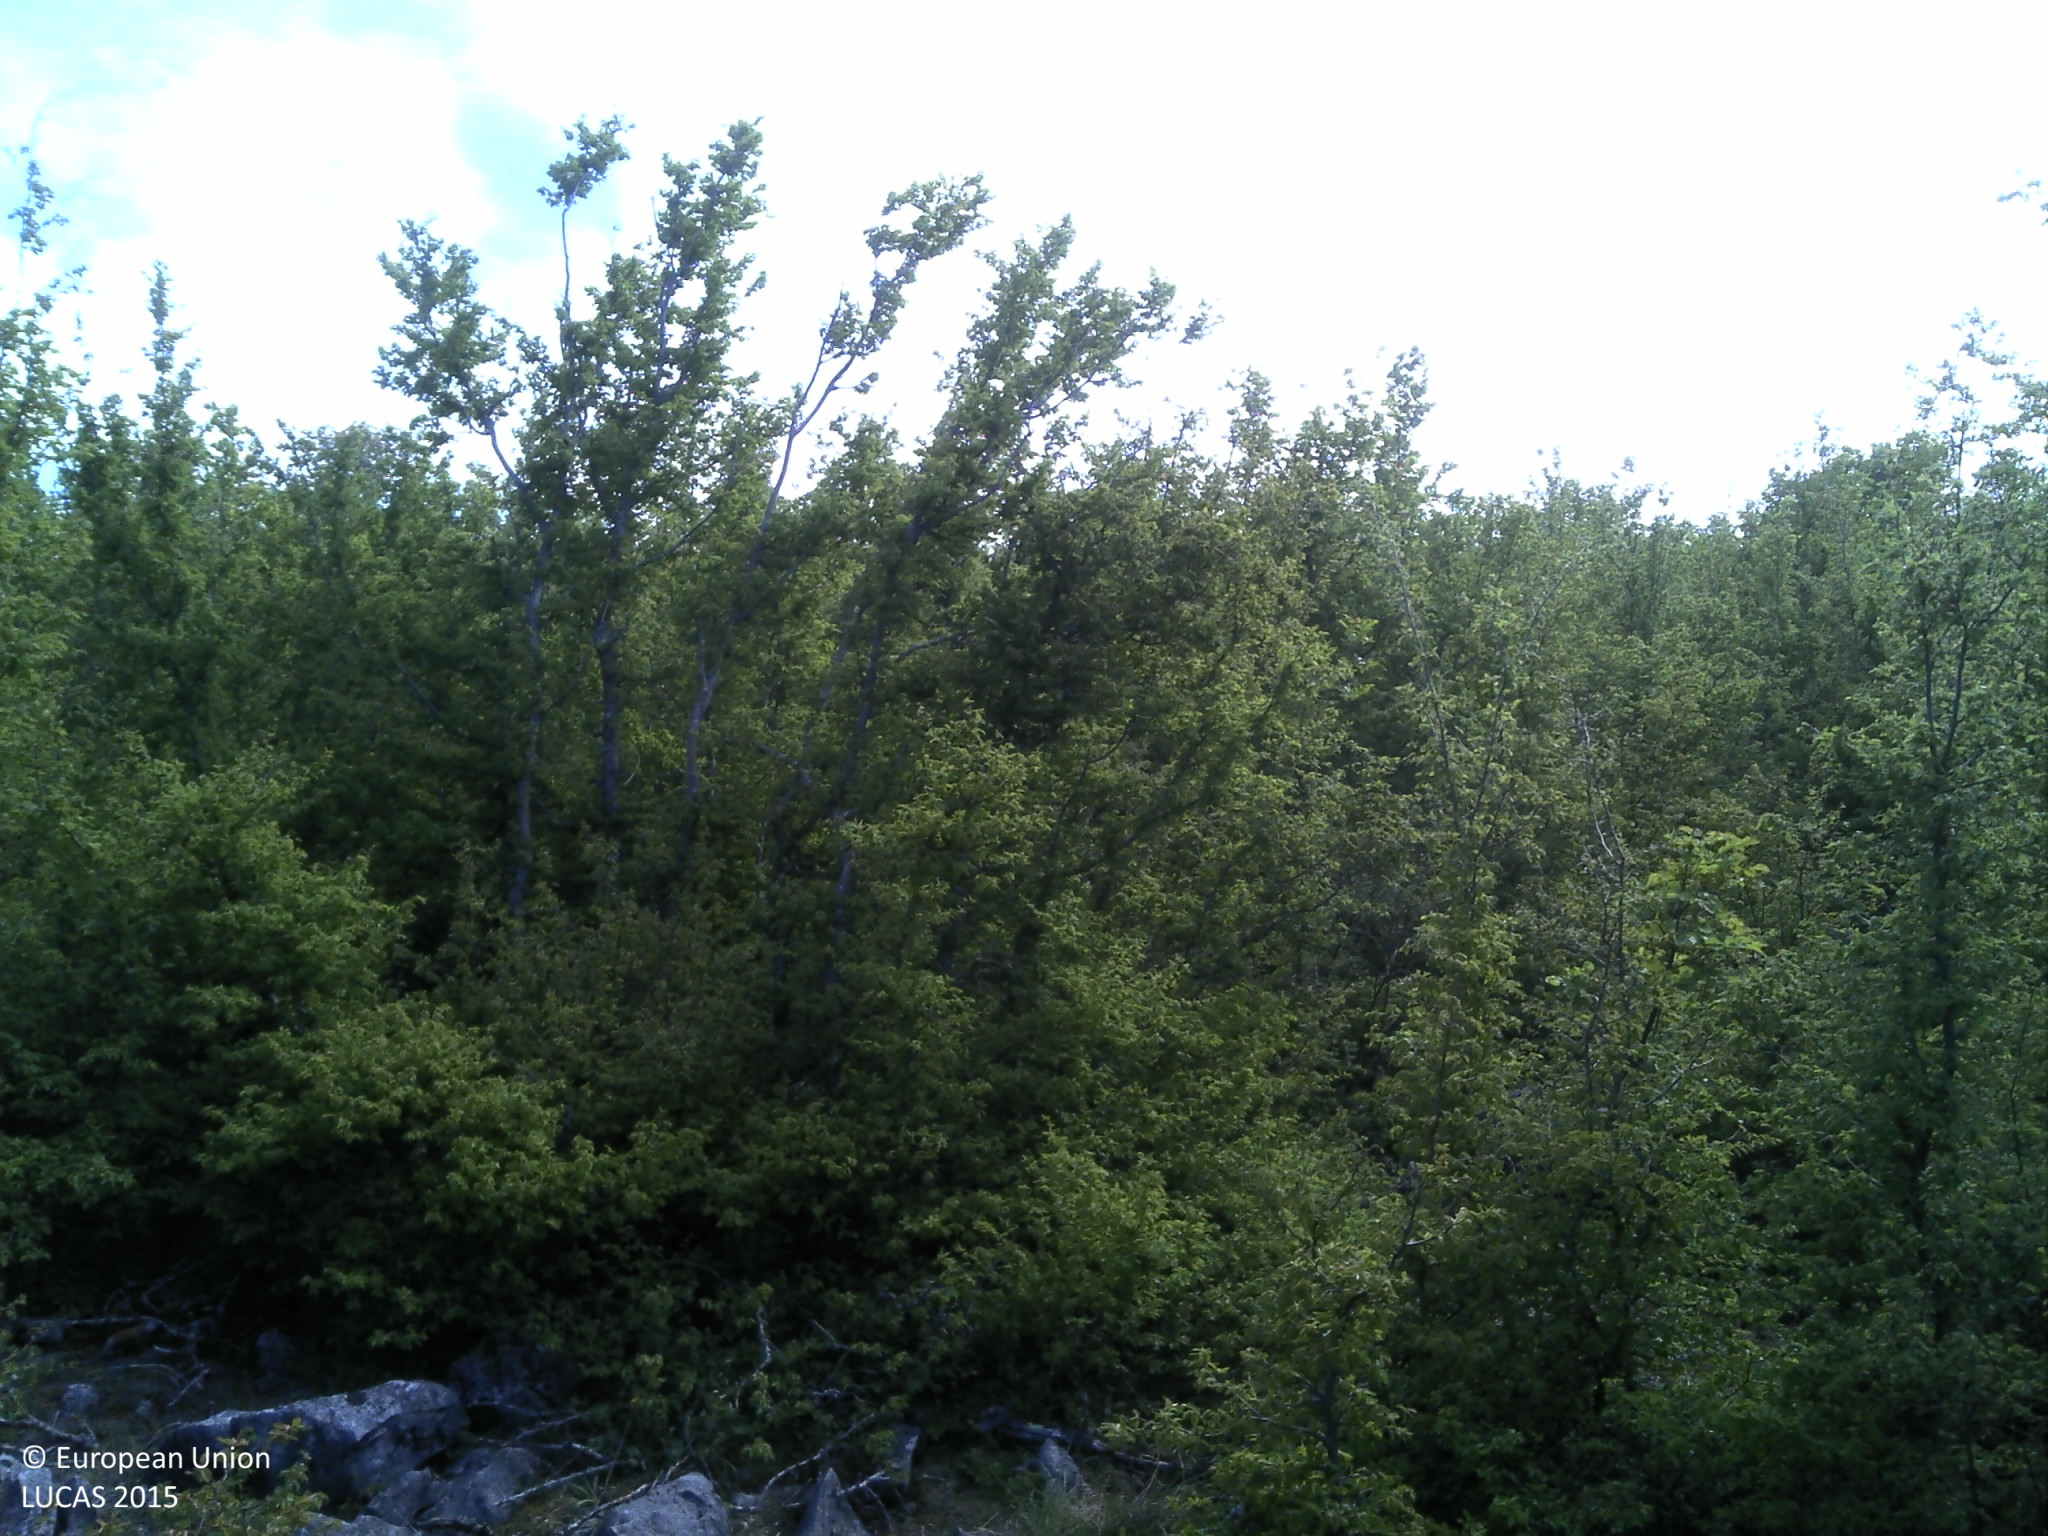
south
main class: Woodland
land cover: Broadleaved woodland
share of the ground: > 75 %
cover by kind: broadleaved forest trees 90 %, herbaceous plants 5 %, unconsolidated bare surface 5 %
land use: Semi-natural and natural areas not in use
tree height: < 5 m
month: April
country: HR
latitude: 44.1835
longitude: 15.8846
